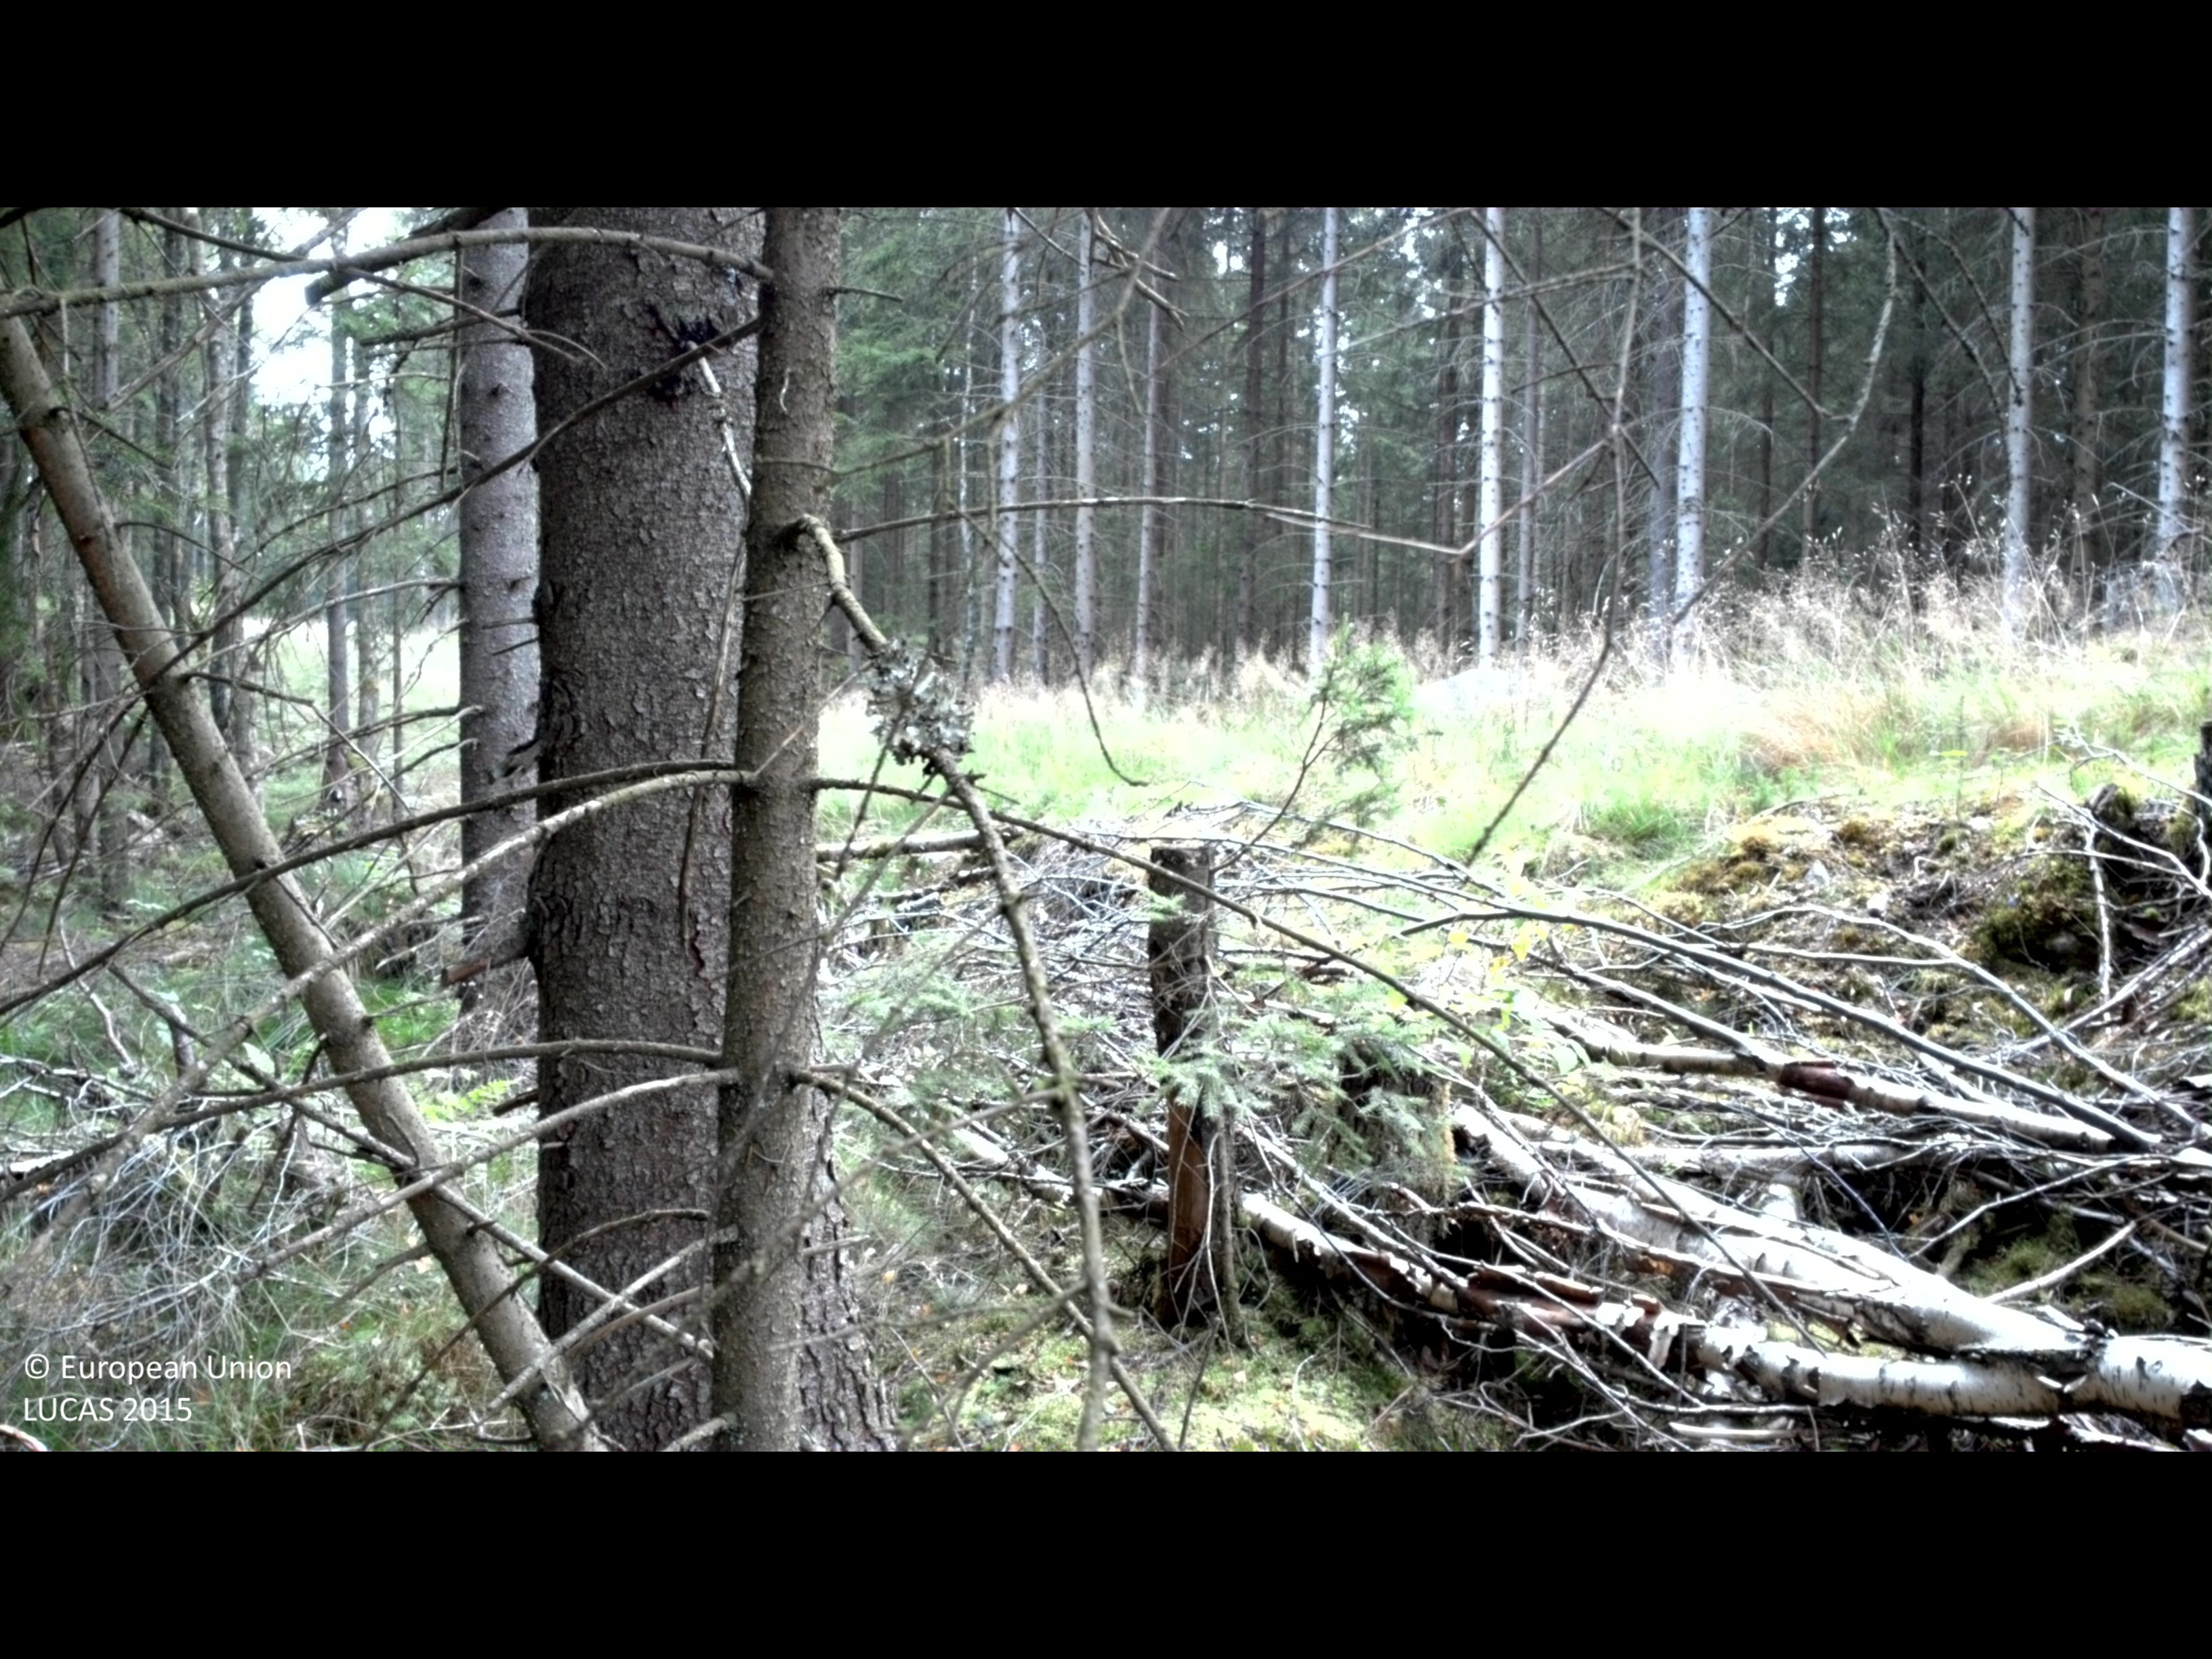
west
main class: Woodland
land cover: Spruce dominated coniferous woodland
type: boreal forest
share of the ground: > 75 %
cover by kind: coniferous forest trees 70 %, lichens and mosses 25 %, broadleaved forest trees 5 %
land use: Forestry
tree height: > 5 m
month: August
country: SE
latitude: 56.8318
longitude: 13.1924
